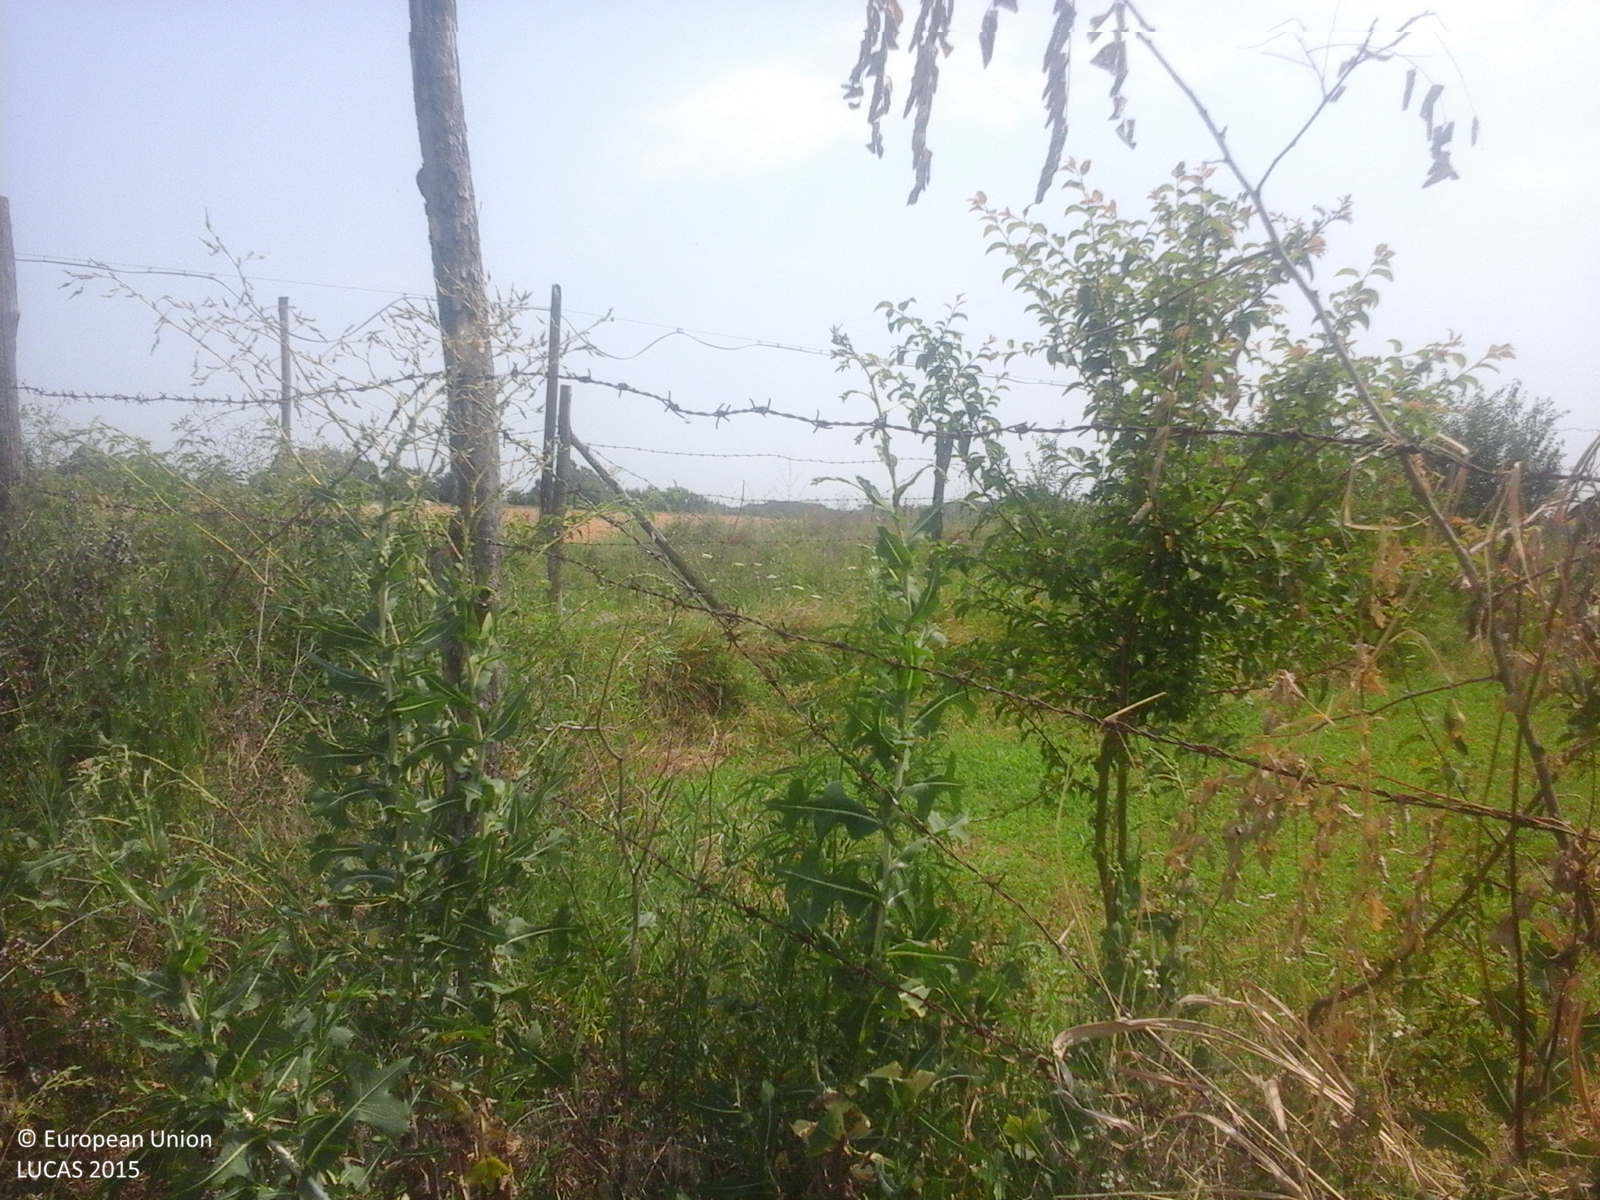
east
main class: Cropland
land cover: Lucerne
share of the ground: > 75 %
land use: Agriculture (excluding fallow land and kitchen gardens)
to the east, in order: Lucerne; Electric lines; Fences; Grass margins; Ditches and canals; Paved roads, cycling and walking lanes; Ditches and canals; Lines of trees; Electric lines; Common wheat; Electric lines; Common wheat
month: July
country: RO
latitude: 44.7698
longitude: 26.3511
